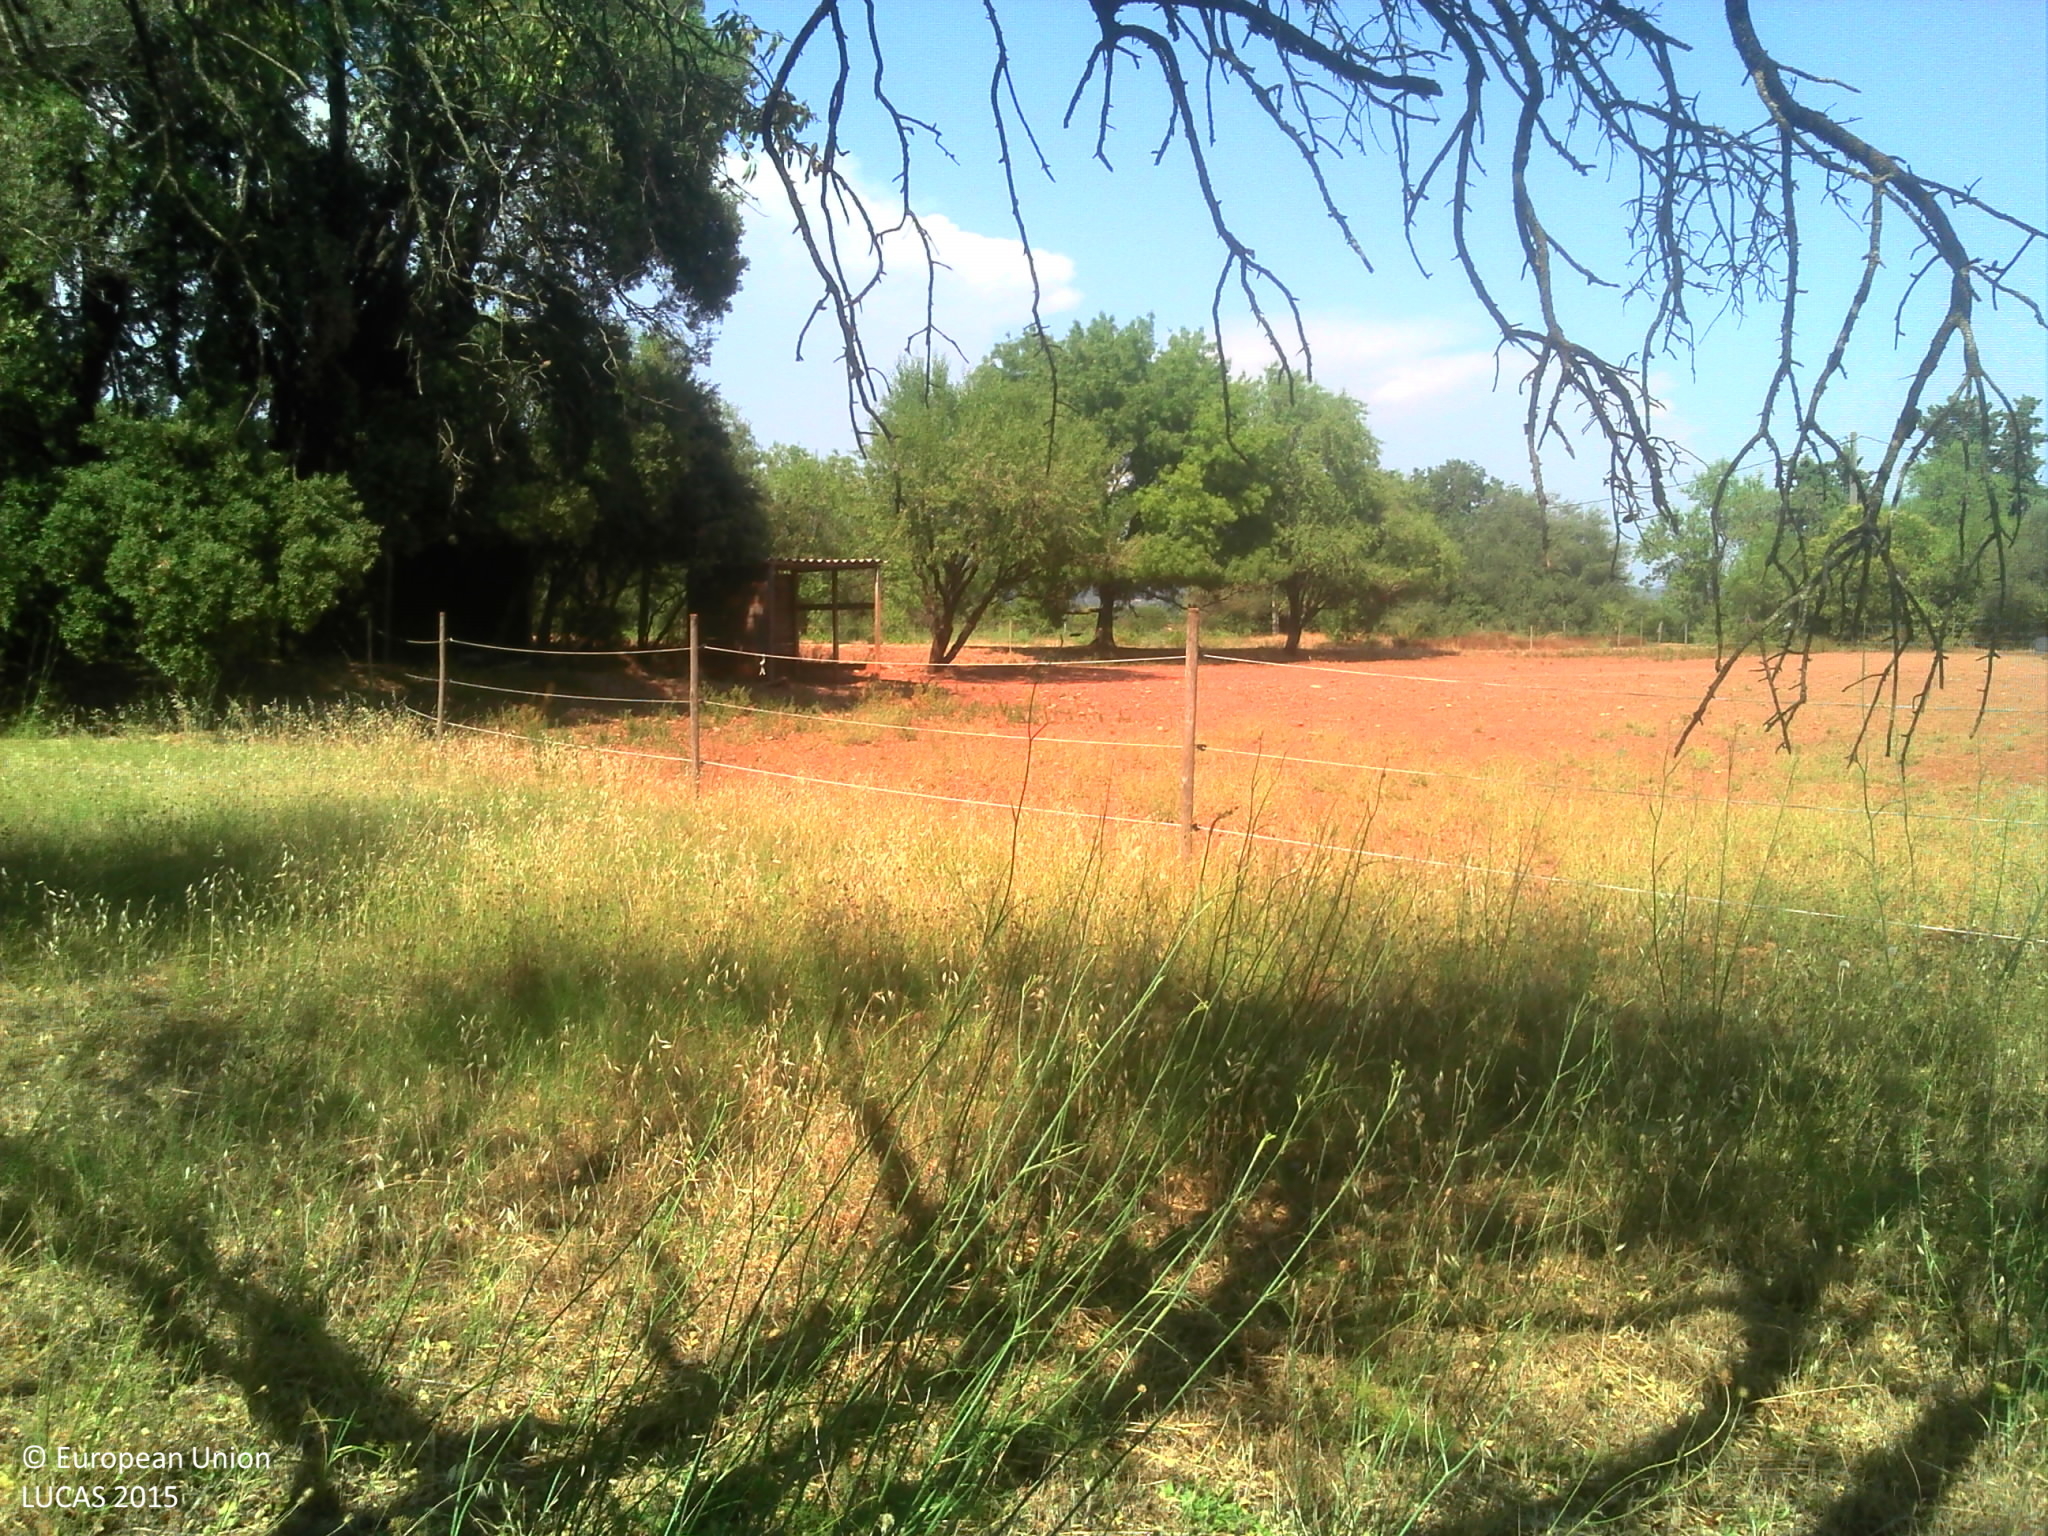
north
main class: Cropland
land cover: Nuts trees
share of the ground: < 10 %
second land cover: Grassland without tree/shrub cover
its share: > 75 %
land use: Kitchen garden
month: July
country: FR
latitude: 43.3634
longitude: 6.2949
